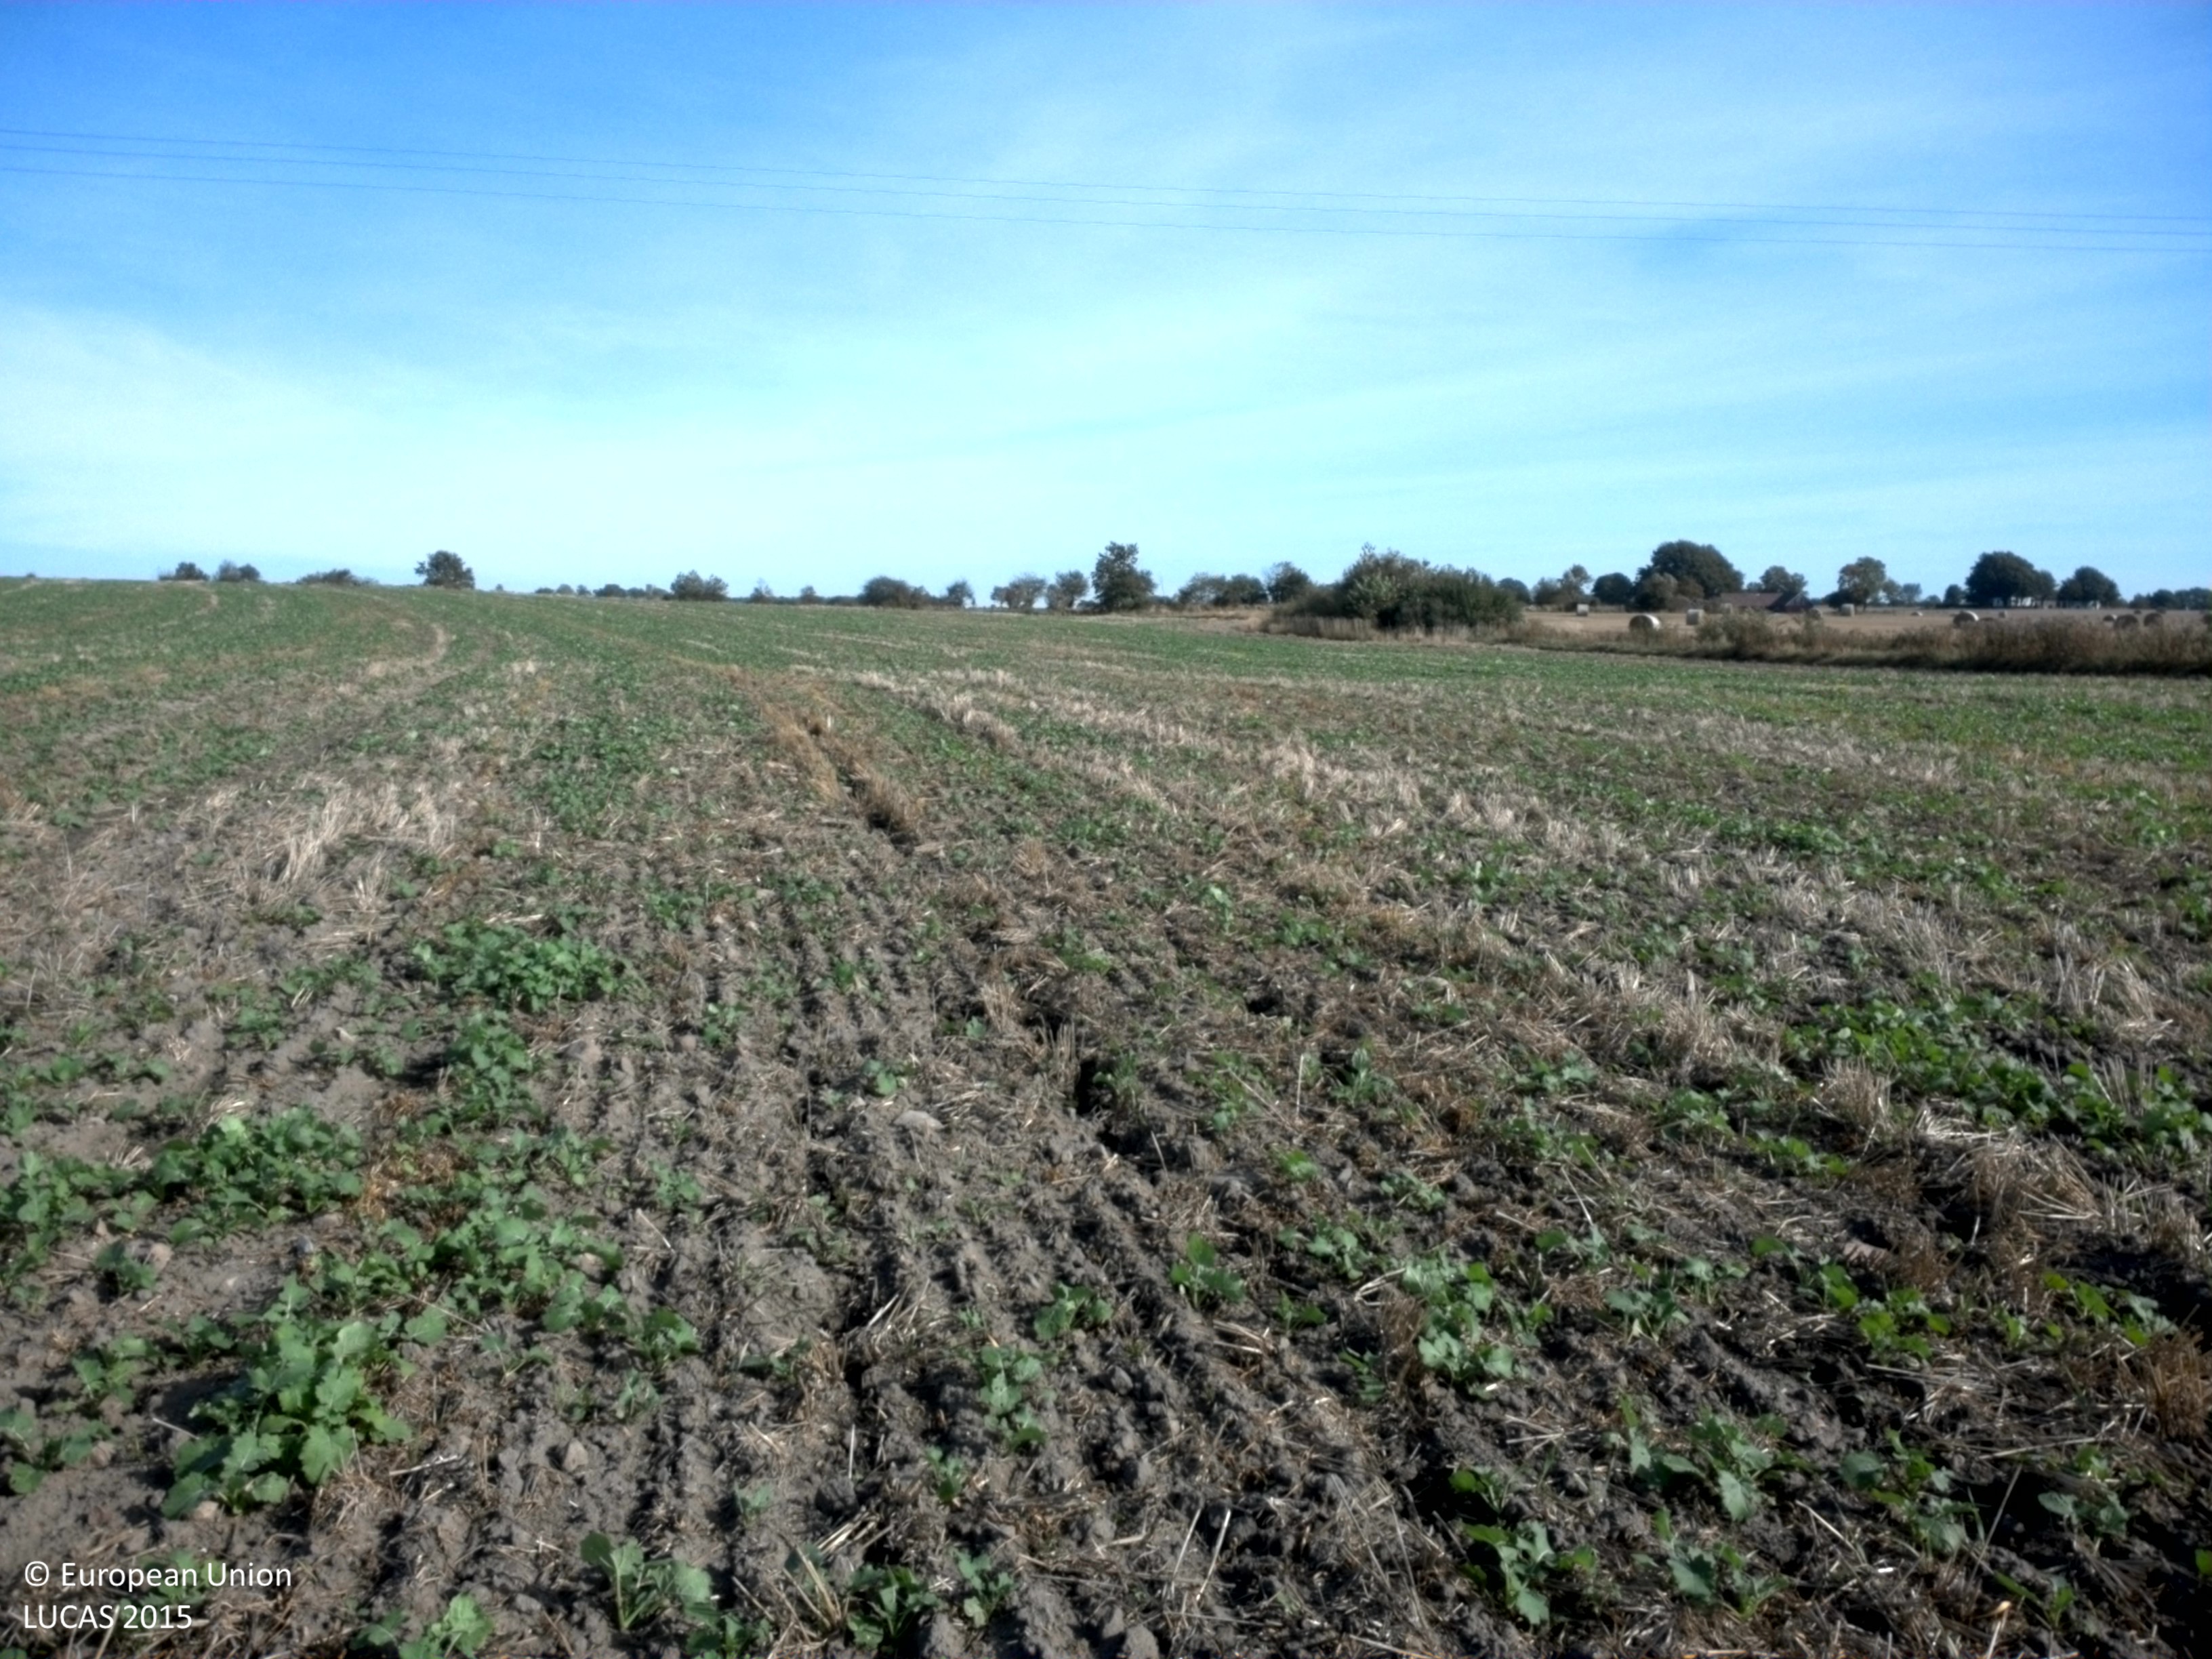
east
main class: Cropland
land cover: Rape and turnip rape
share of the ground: 25 - 50 %
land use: Agriculture (excluding fallow land and kitchen gardens)
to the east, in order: Rape and turnip rape; Electric lines; Rape and turnip rape; Grass margins; Ditches and canals; Grass margins; Common wheat; Dry stone walls; Single bushes/trees; Temporary grasslands
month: October
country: SE
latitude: 55.7751
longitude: 13.6806
